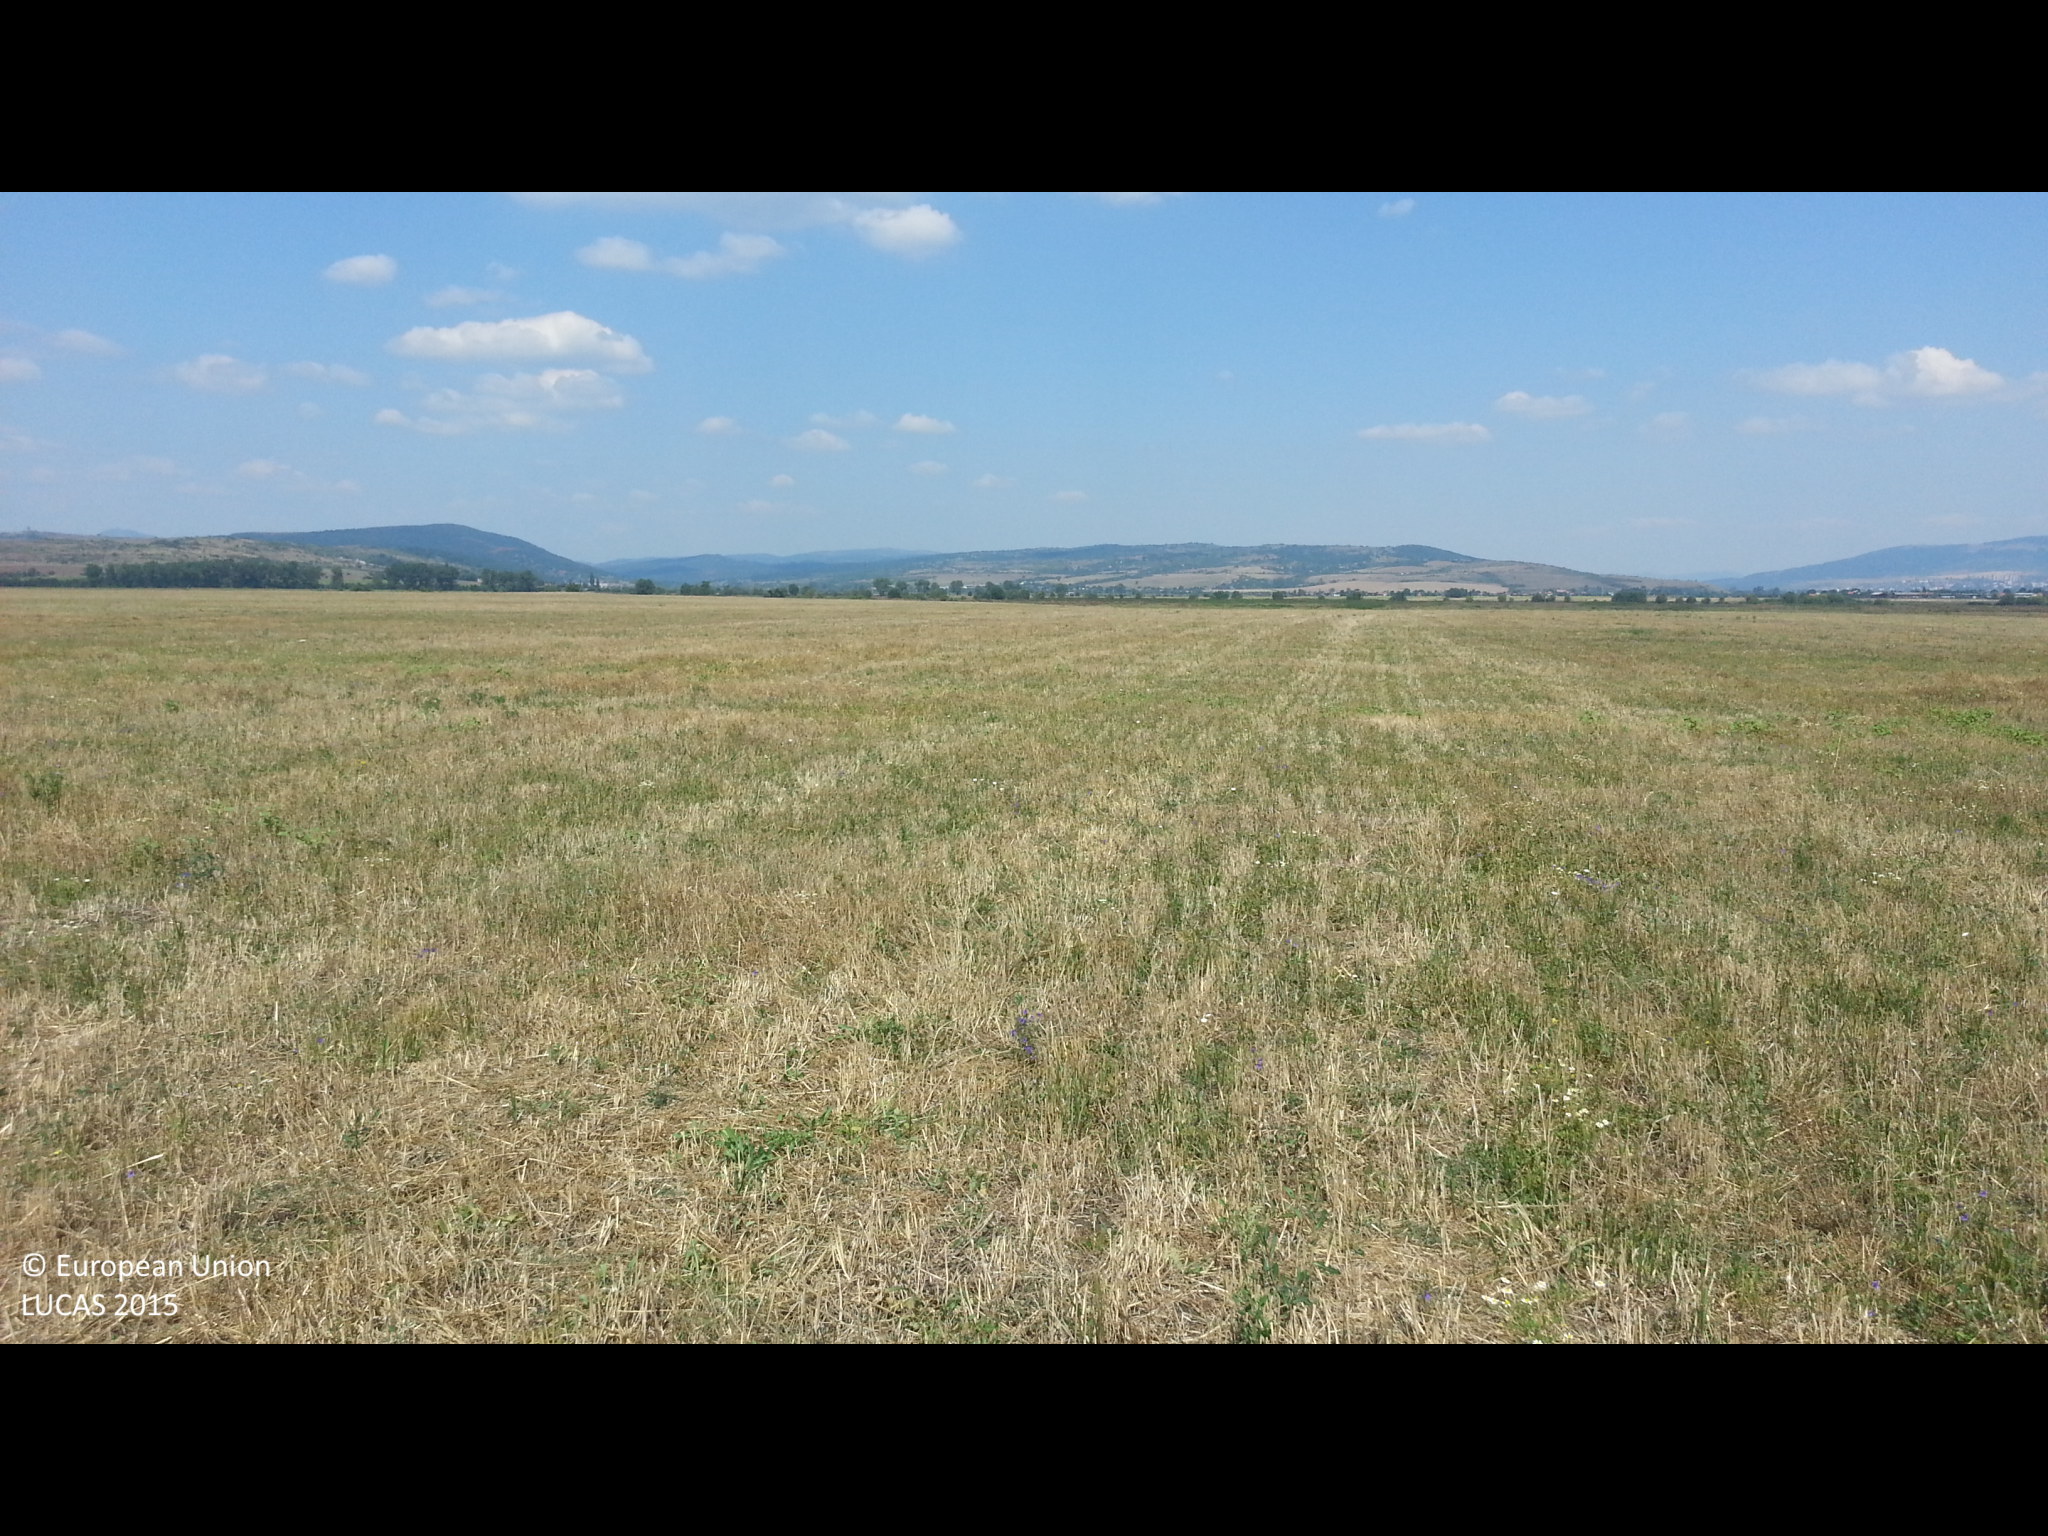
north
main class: Cropland
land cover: Common wheat
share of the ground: > 75 %
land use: Agriculture (excluding fallow land and kitchen gardens)
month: August
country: BG
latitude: 42.4608
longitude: 22.9293
